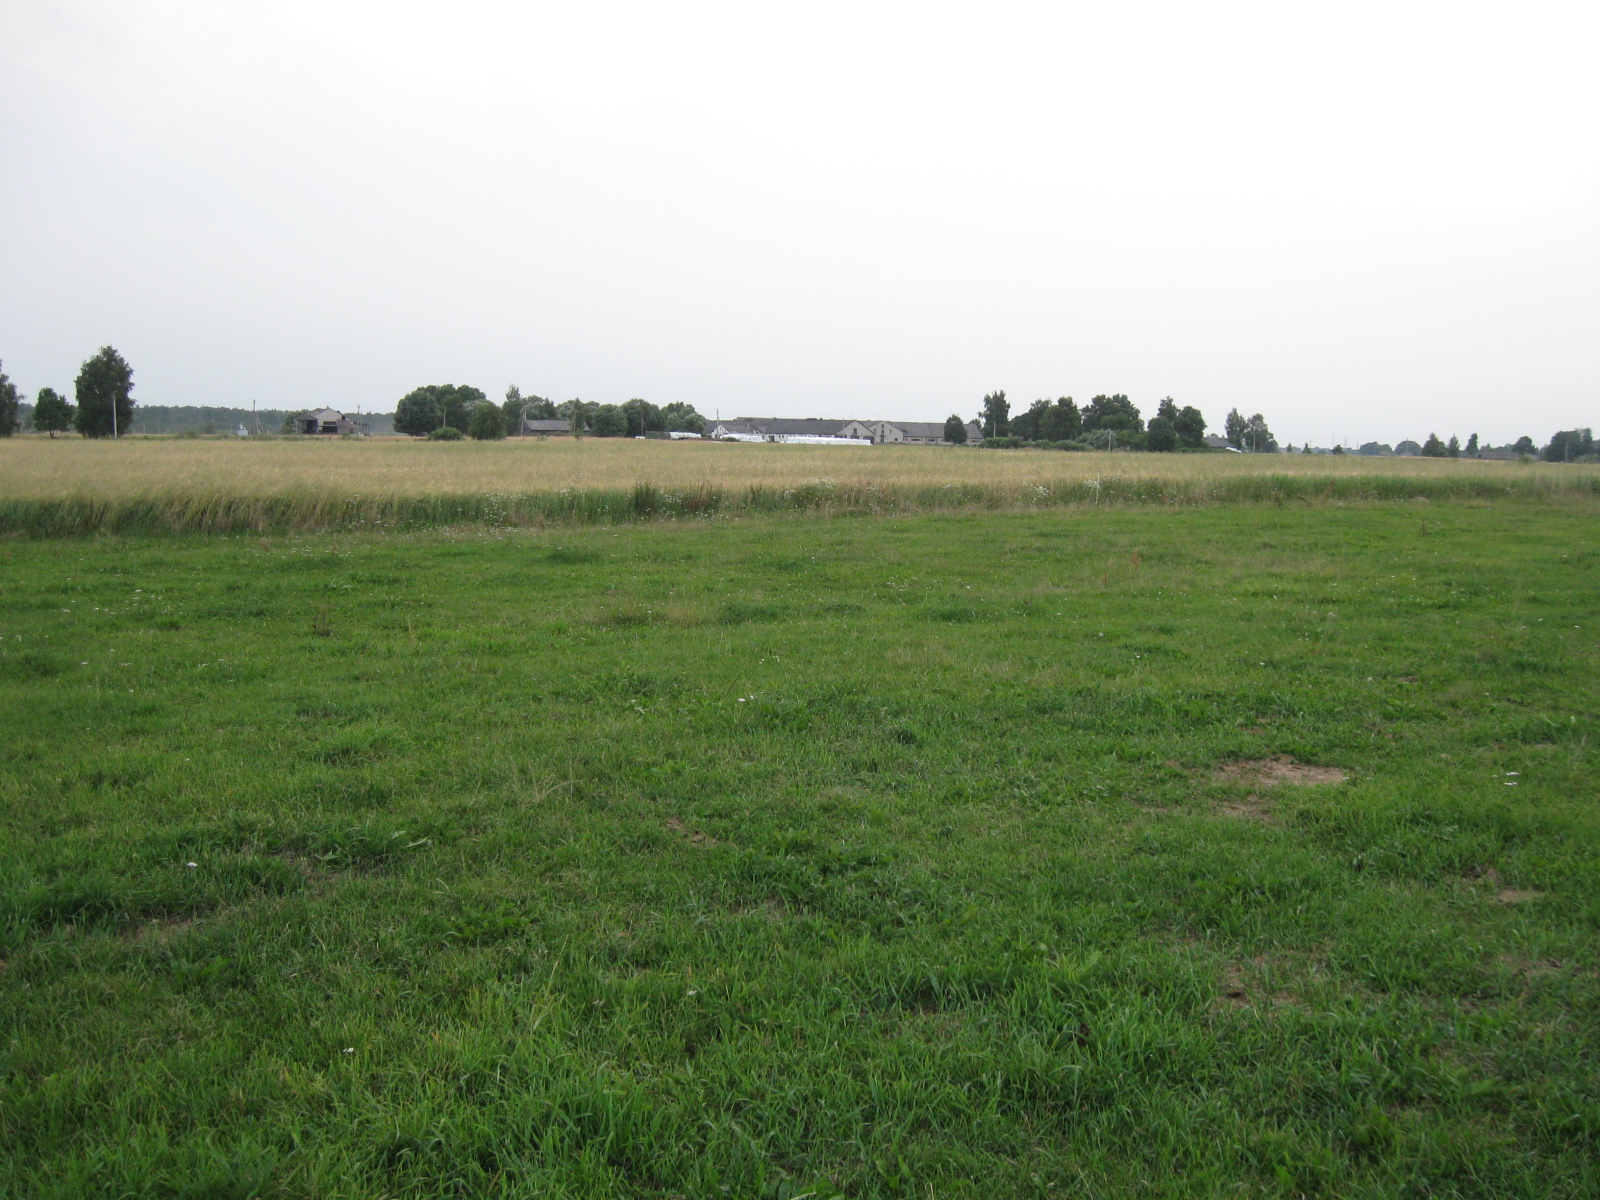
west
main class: Grassland
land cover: Grassland without tree/shrub cover
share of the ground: > 75 %
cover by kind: herbaceous plants 95 %, unconsolidated bare surface 5 %
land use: Agriculture (excluding fallow land and kitchen gardens)
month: July
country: LT
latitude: 54.7075
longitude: 23.7915
